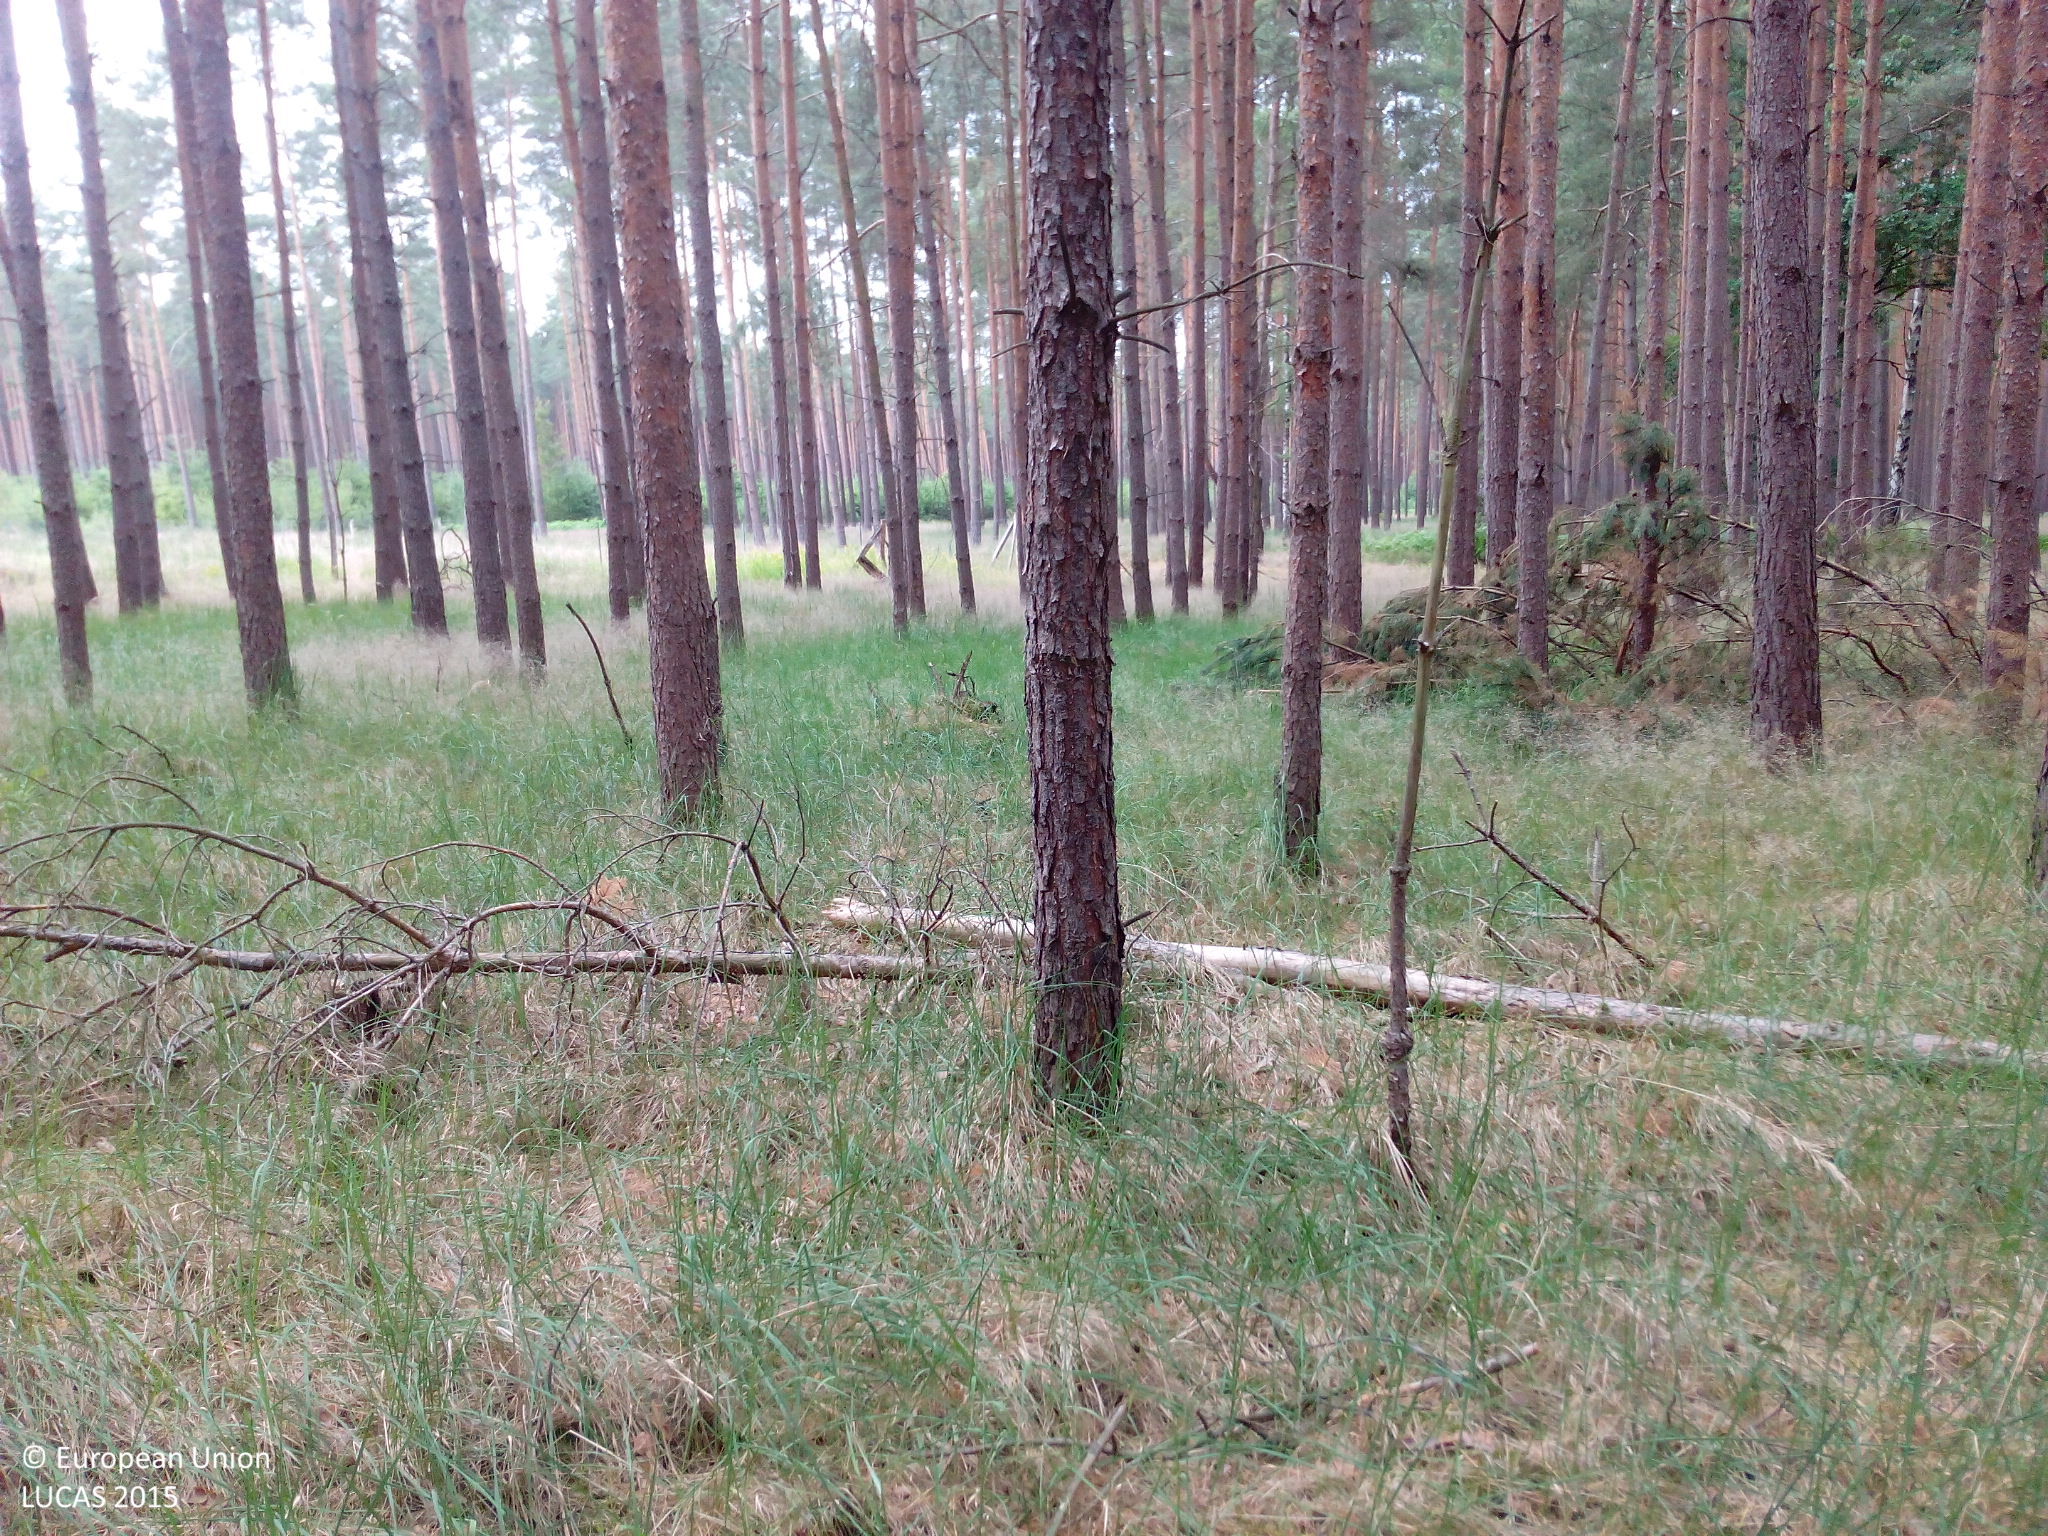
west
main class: Woodland
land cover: Pine dominated coniferous woodland
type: hemiboreal forest and nemoral coniferous forest and mixed broadleaved-coniferous forest
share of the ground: > 75 %
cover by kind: coniferous forest trees 90 %, herbaceous plants 10 %
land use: Forestry
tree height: > 5 m
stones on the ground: < 10 %
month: June
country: DE
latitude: 52.1905
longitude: 12.4425
